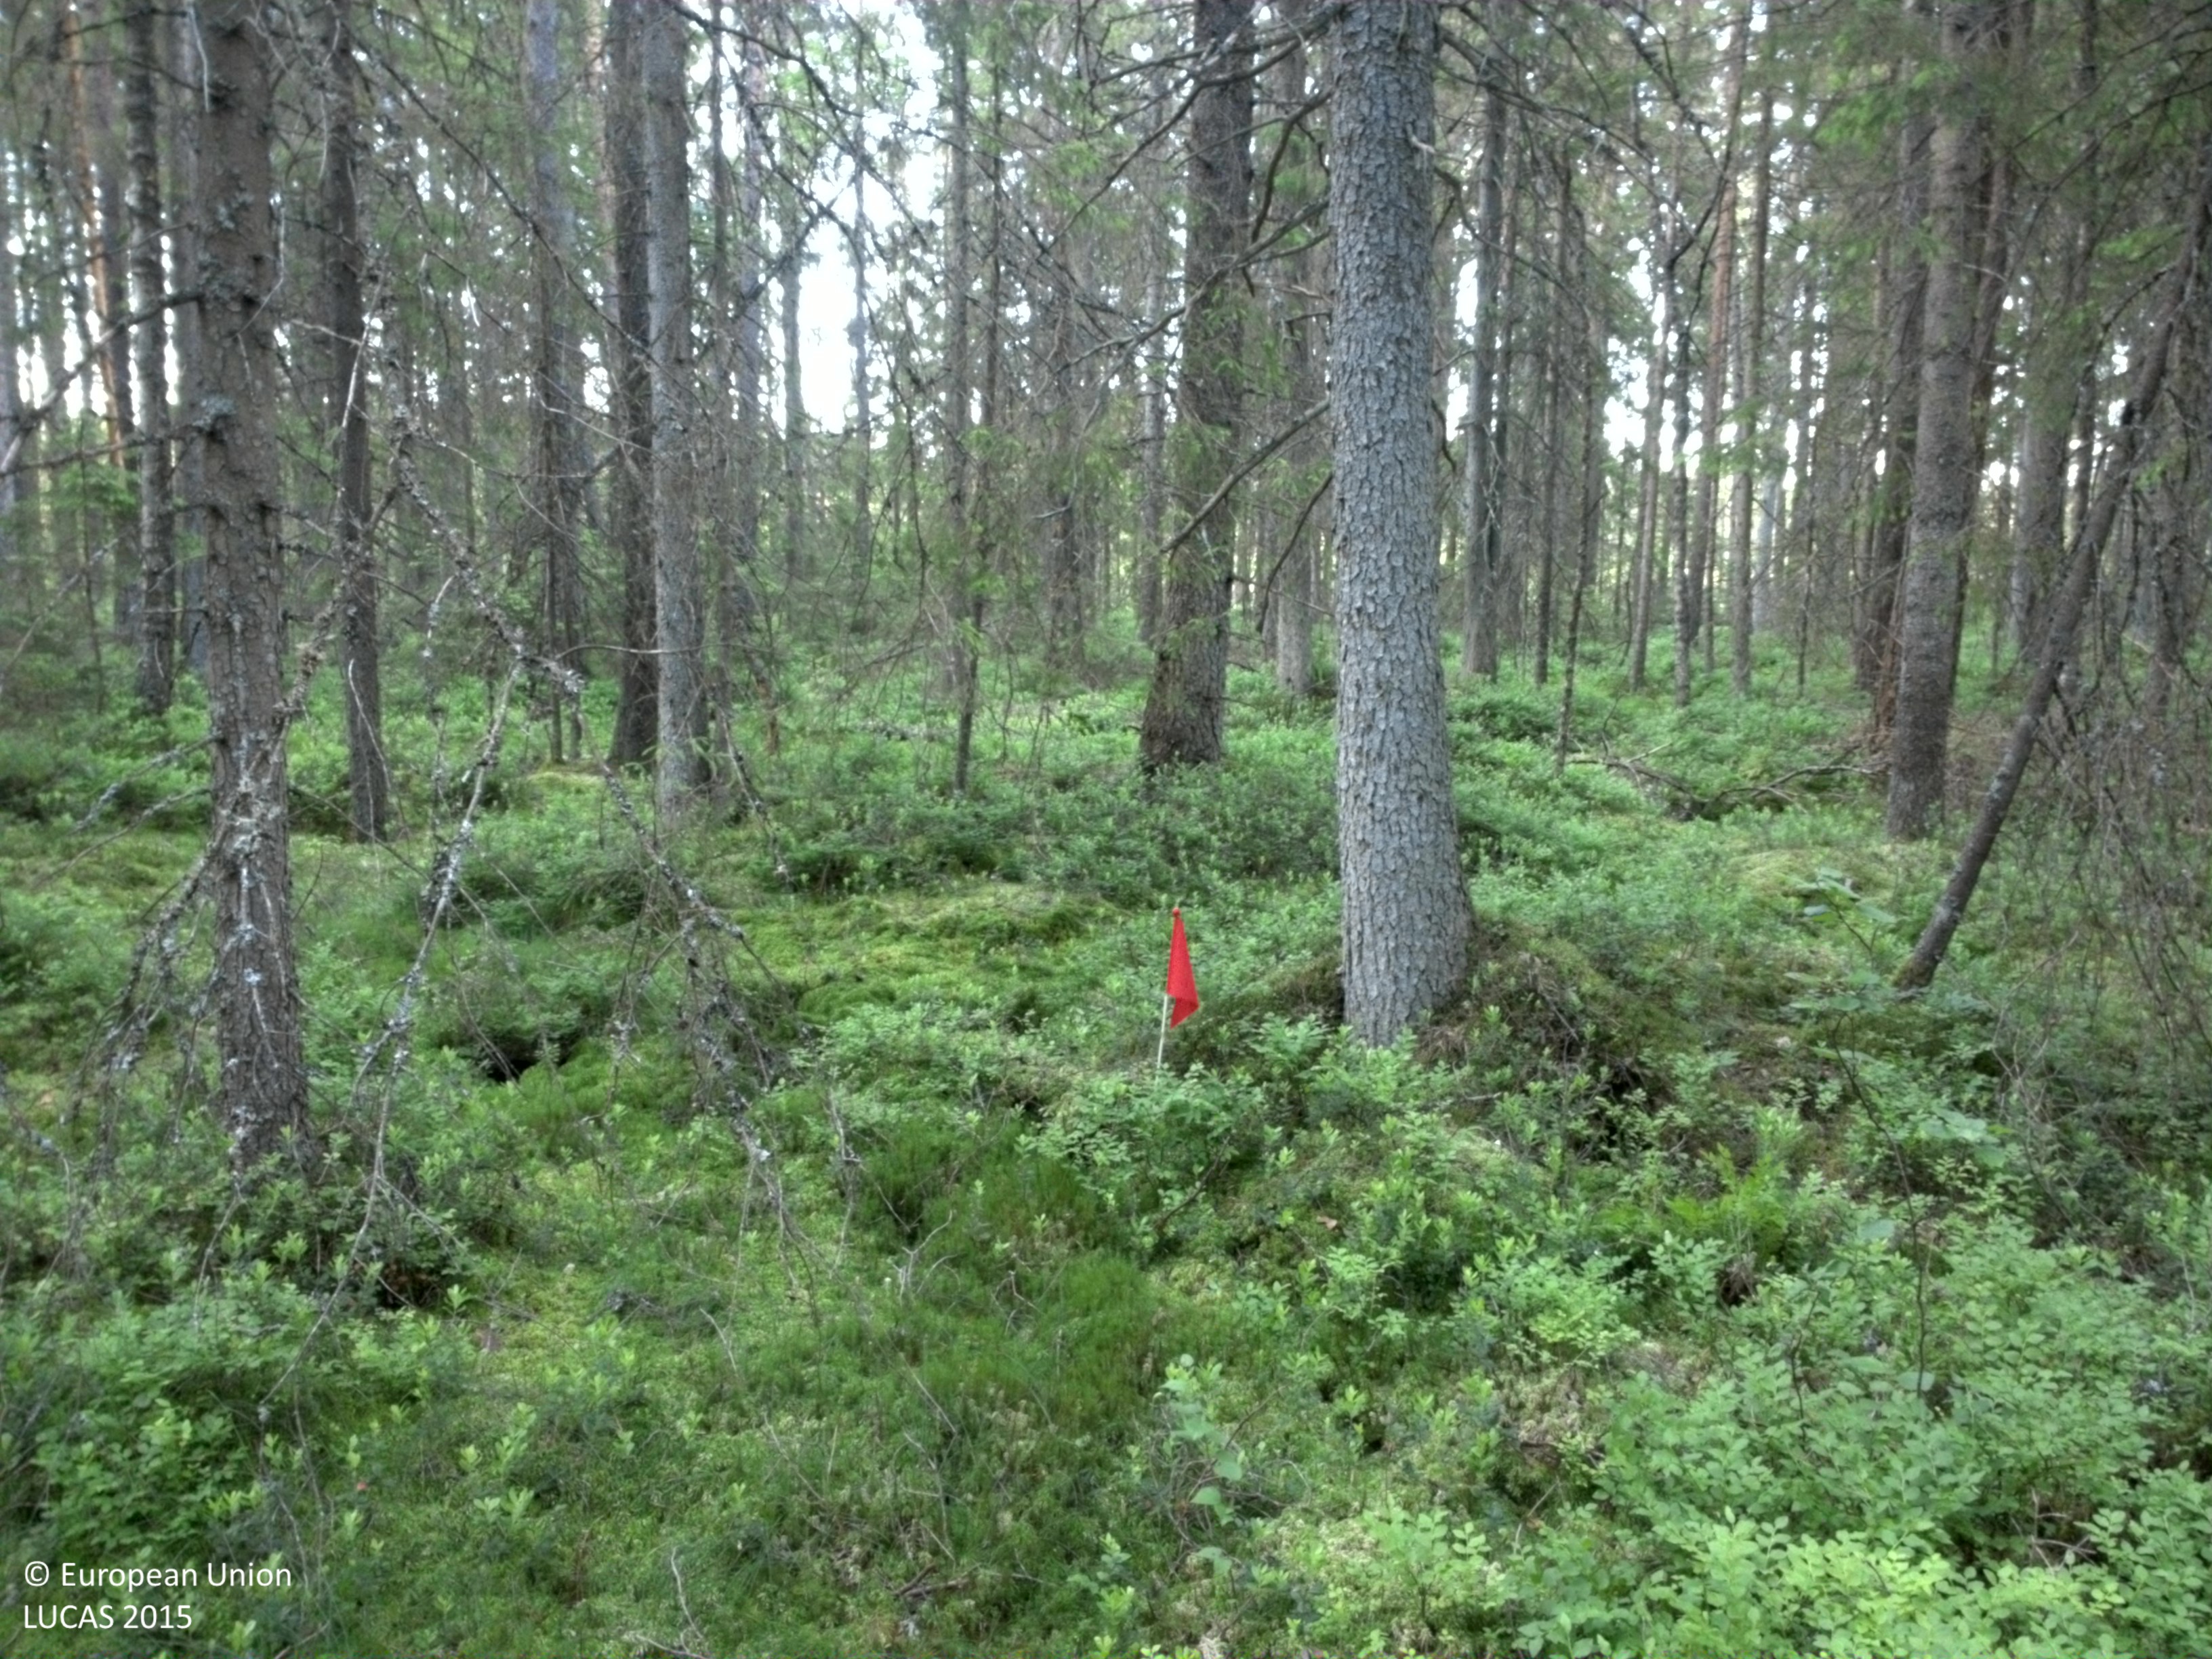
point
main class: Woodland
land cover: Spruce dominated coniferous woodland
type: boreal forest
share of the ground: 50 - 75 %
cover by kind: coniferous forest trees 75 %, lichens and mosses 15 %, shrubs 10 %
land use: Forestry
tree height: > 5 m
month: June
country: SE
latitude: 57.7116
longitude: 13.9395
